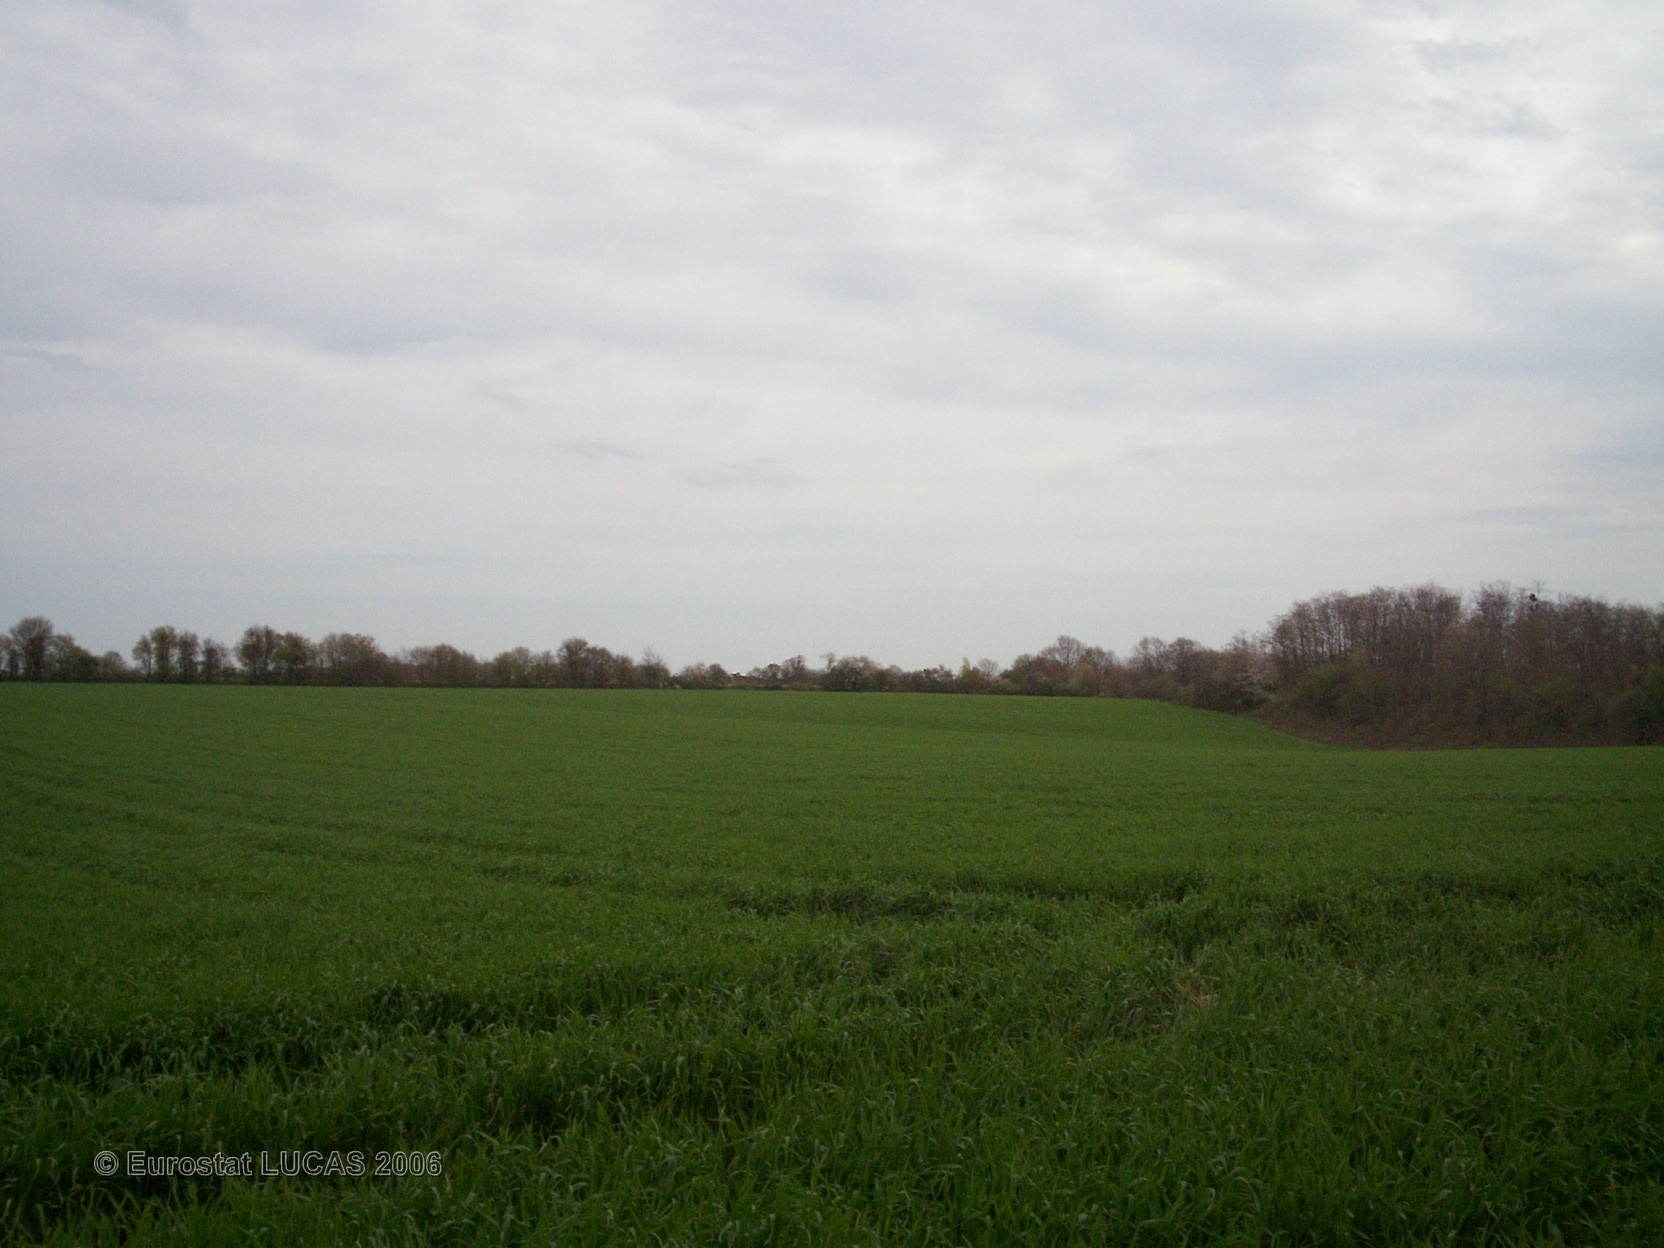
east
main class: Cropland
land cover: Common wheat
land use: Agriculture (excluding fallow land and kitchen gardens)
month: April
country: FR
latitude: 46.1780
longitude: 0.4624
